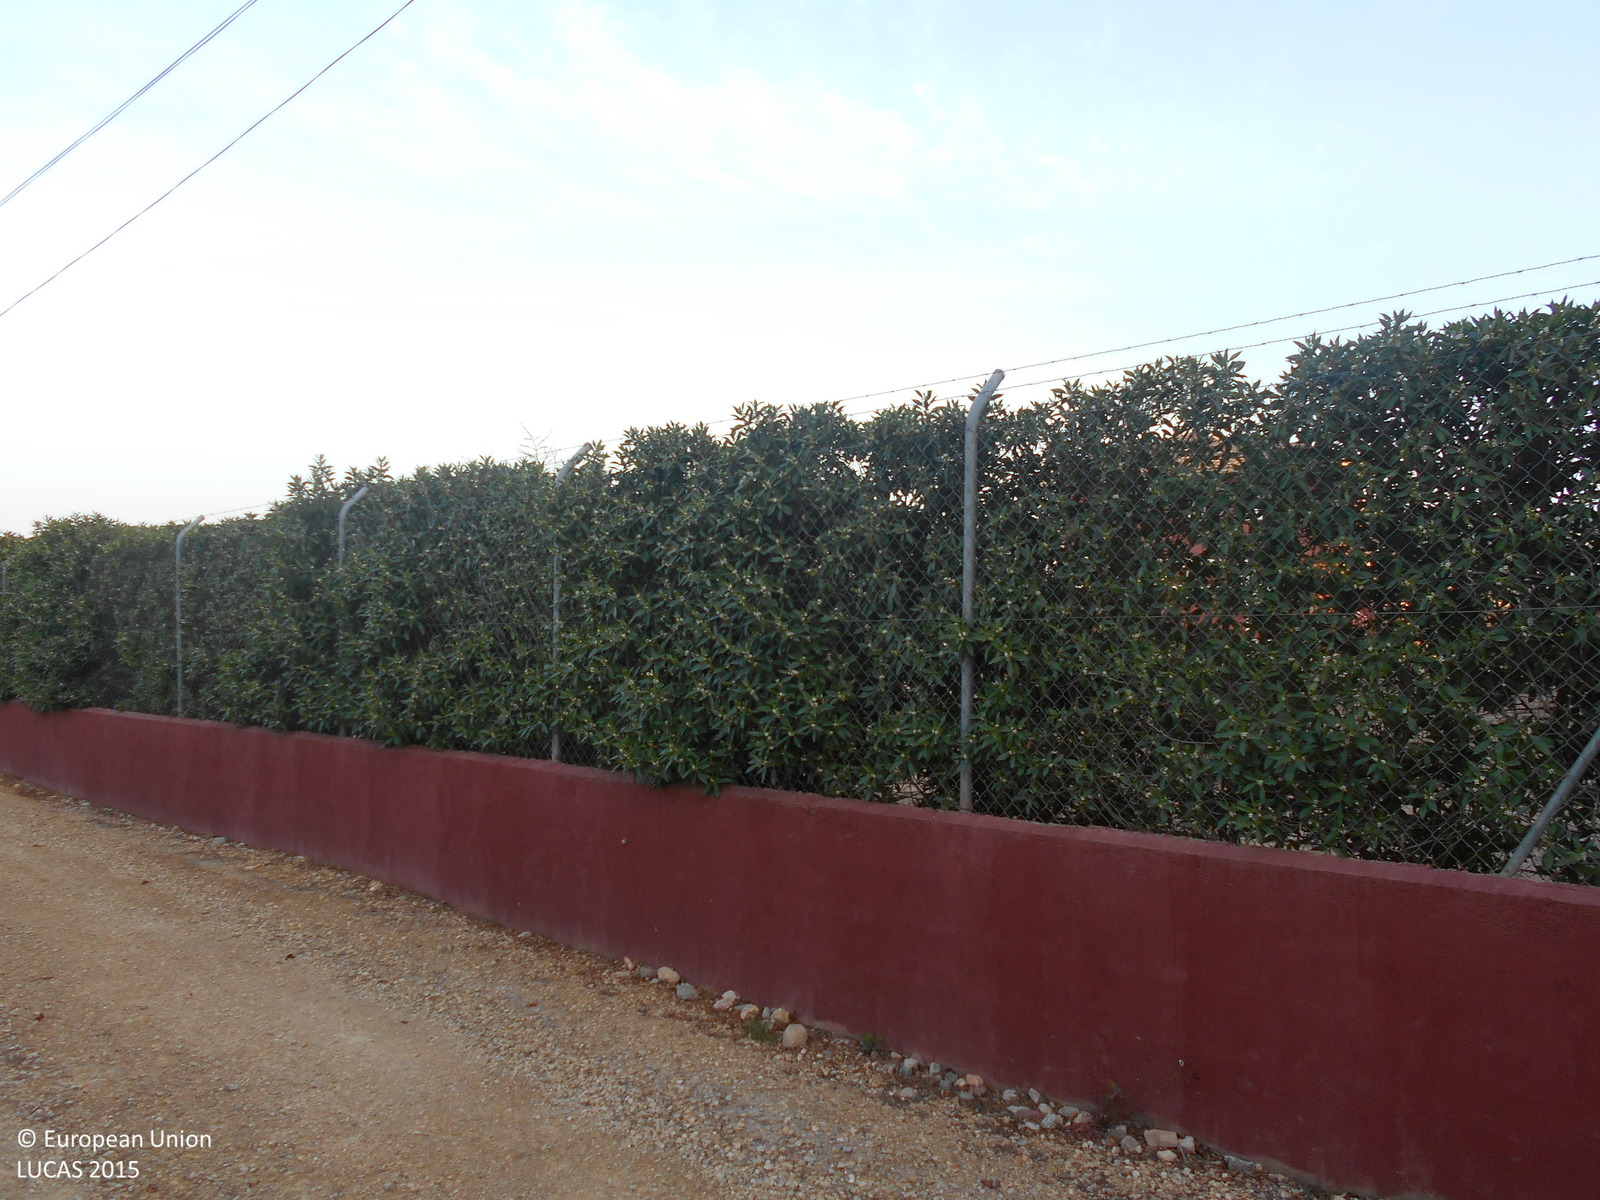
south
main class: Cropland
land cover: Nuts trees
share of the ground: 50 - 75 %
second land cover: Other bare soil
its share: > 75 %
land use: Agriculture (excluding fallow land and kitchen gardens)
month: April
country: ES
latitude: 37.7758
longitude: -1.5295
